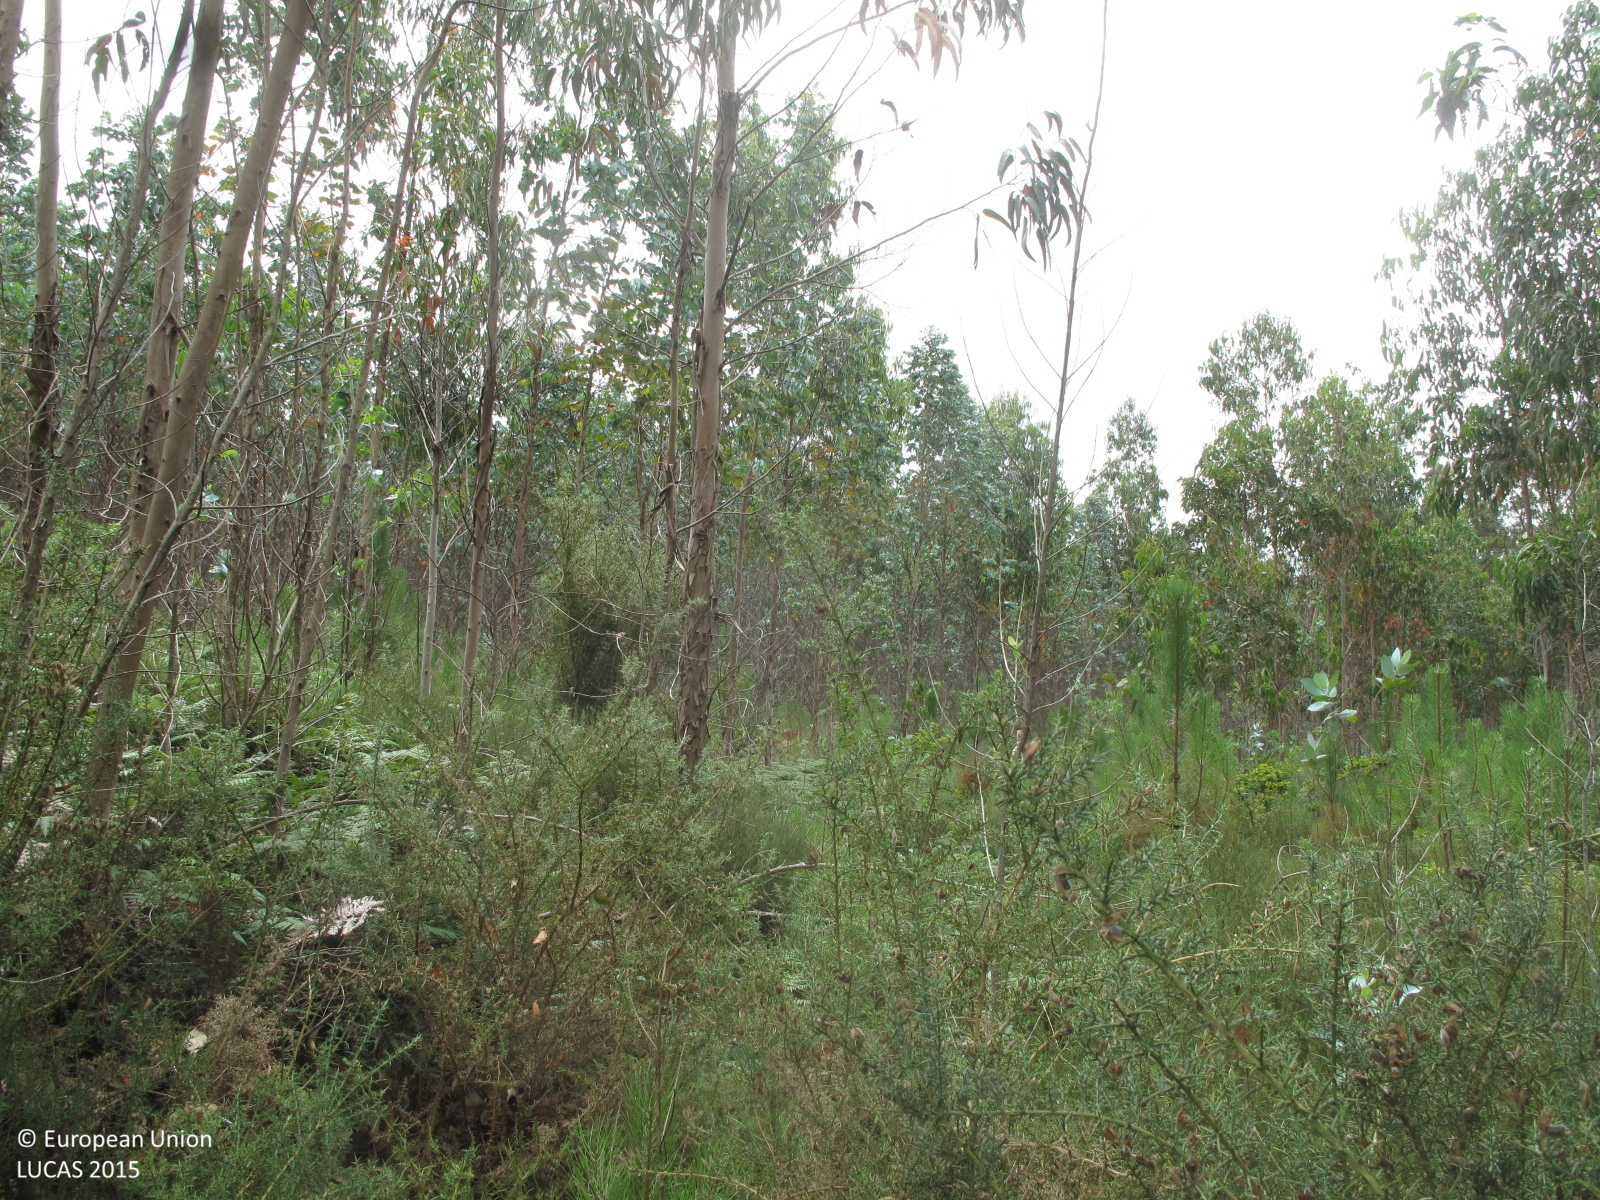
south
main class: Woodland
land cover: Broadleaved woodland
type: exotic forest
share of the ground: 25 - 50 %
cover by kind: broadleaved forest trees 45 %, herbaceous plants 30 %, shrubs 20 %, coniferous forest trees 5 %
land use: Forestry
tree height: > 5 m
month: July
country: ES
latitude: 43.0161
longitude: -9.2081
